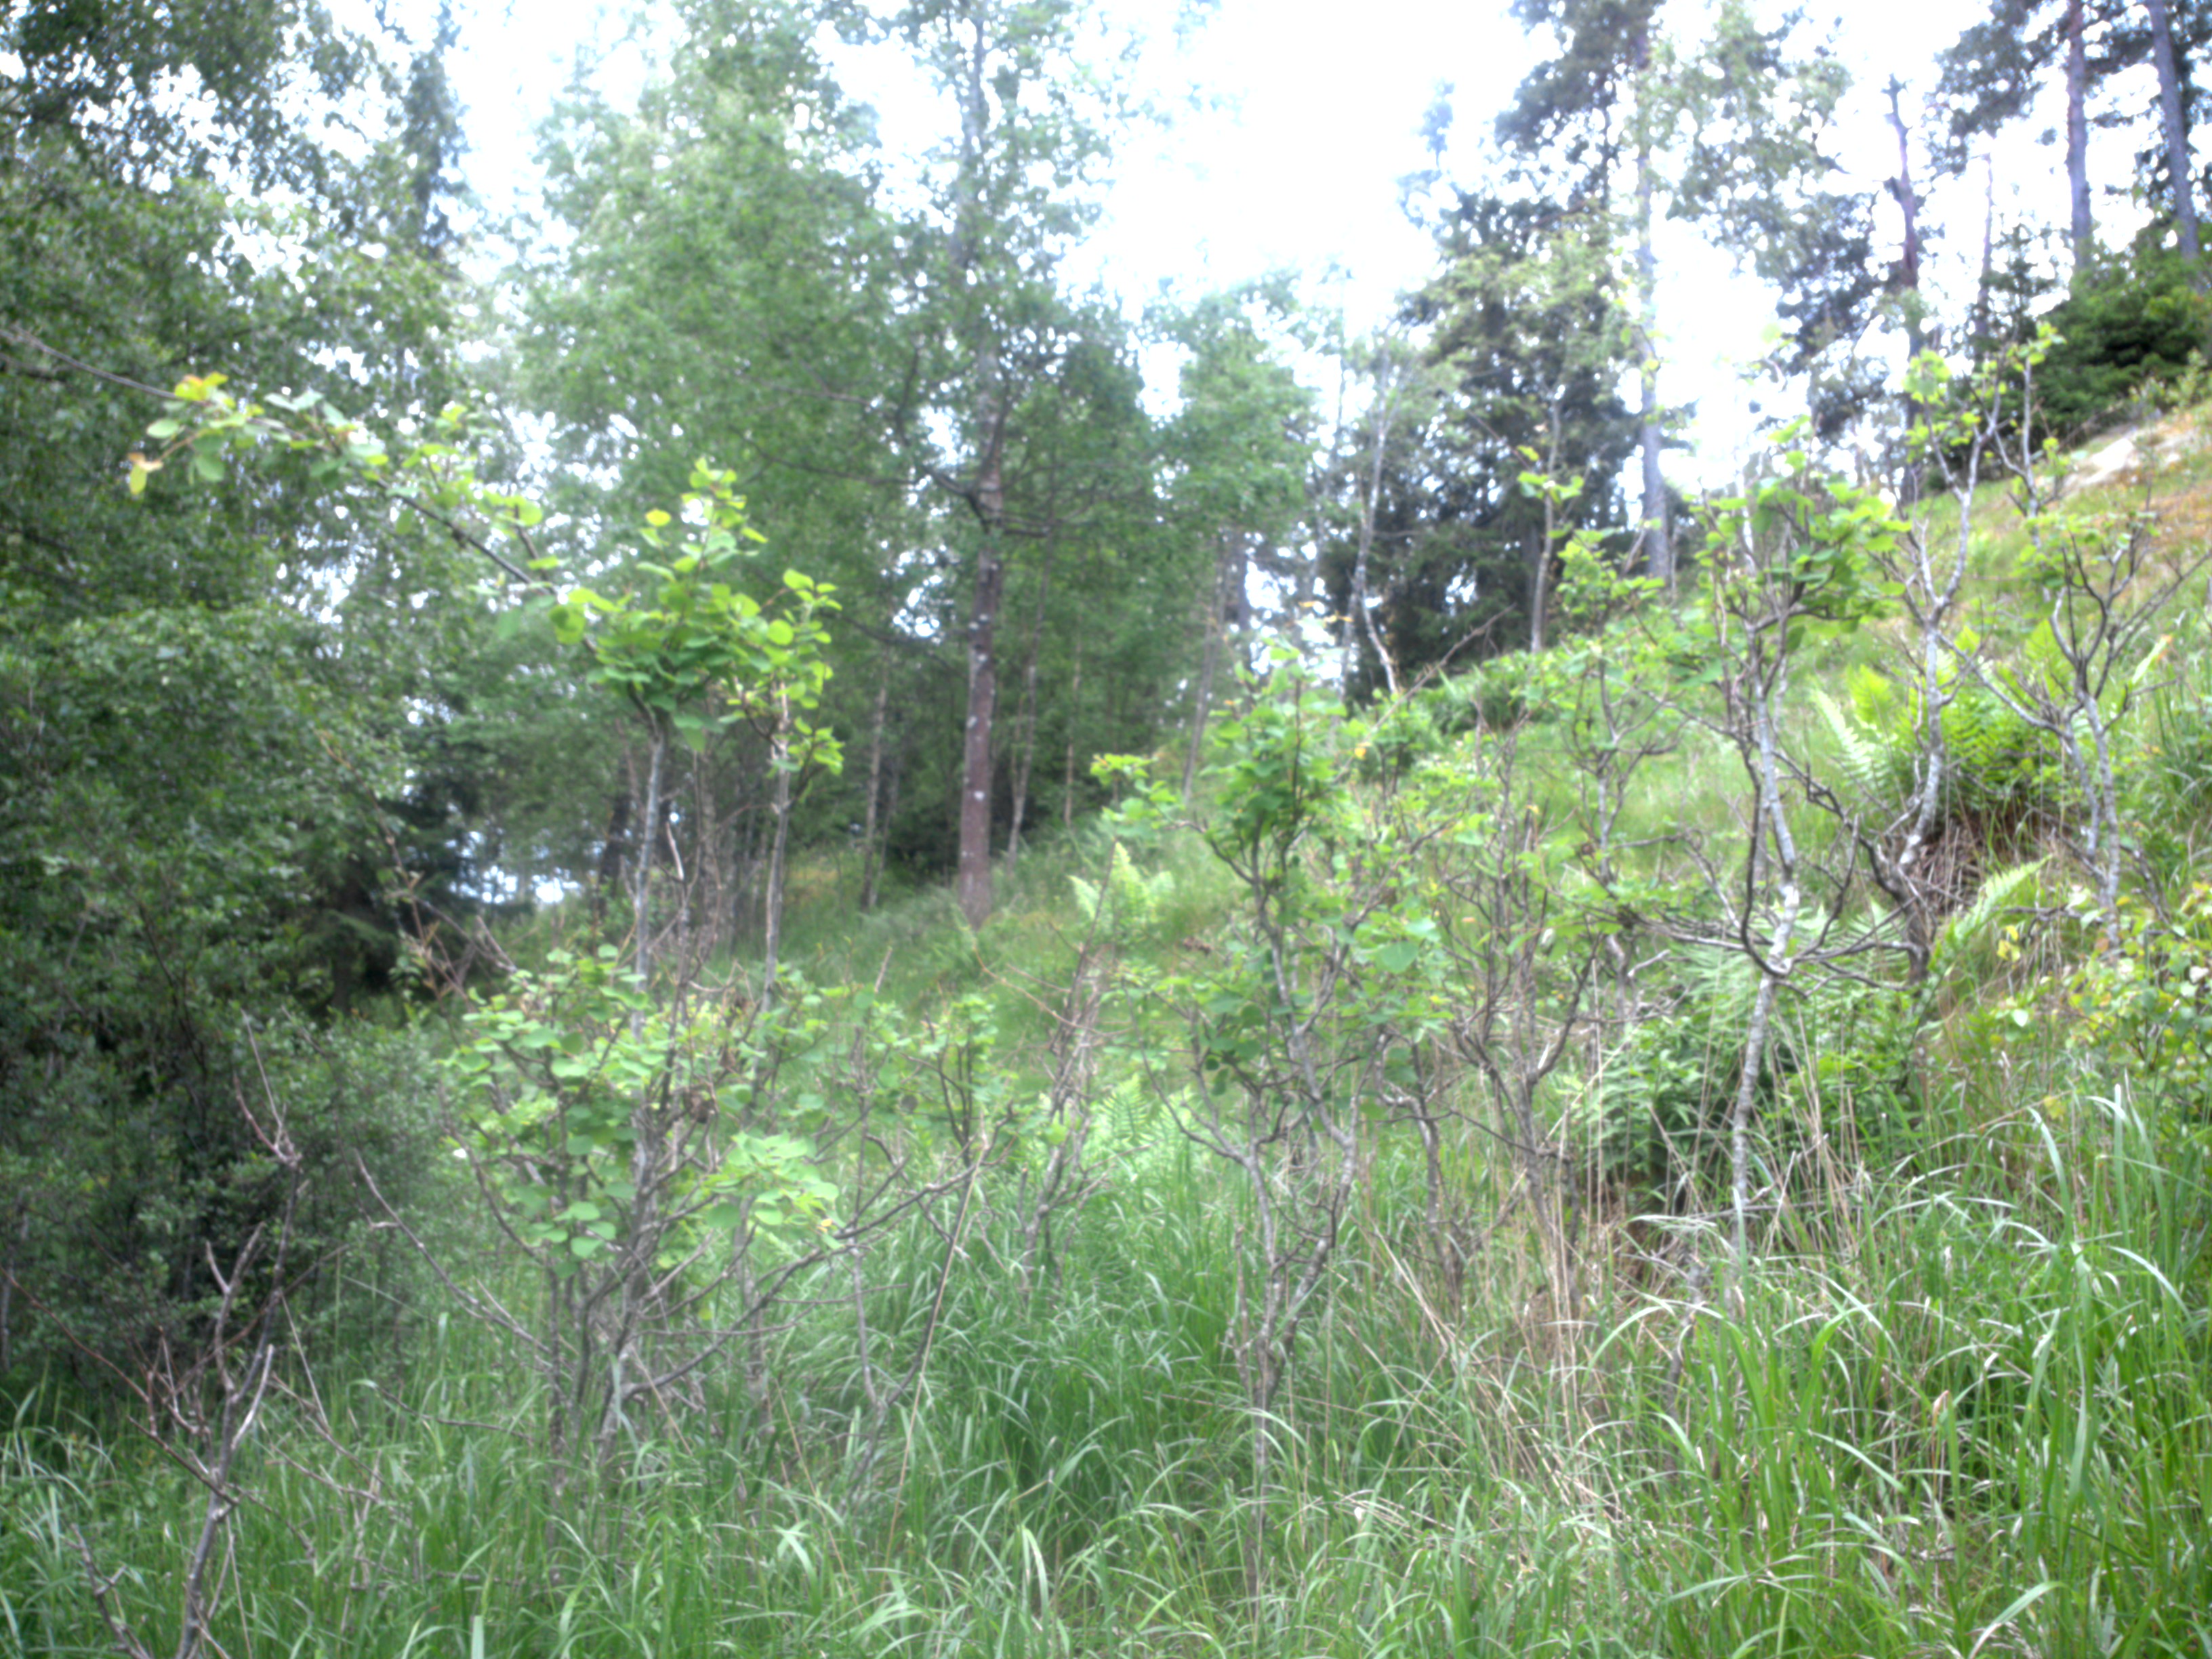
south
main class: Woodland
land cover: Broadleaved woodland
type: hemiboreal forest and nemoral coniferous forest and mixed broadleaved-coniferous forest
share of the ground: 10 - 25 %
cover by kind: herbaceous plants 80 %, broadleaved forest trees 20 %
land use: Semi-natural and natural areas not in use
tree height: > 5 m
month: June
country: SE
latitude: 59.2487
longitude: 17.6596
